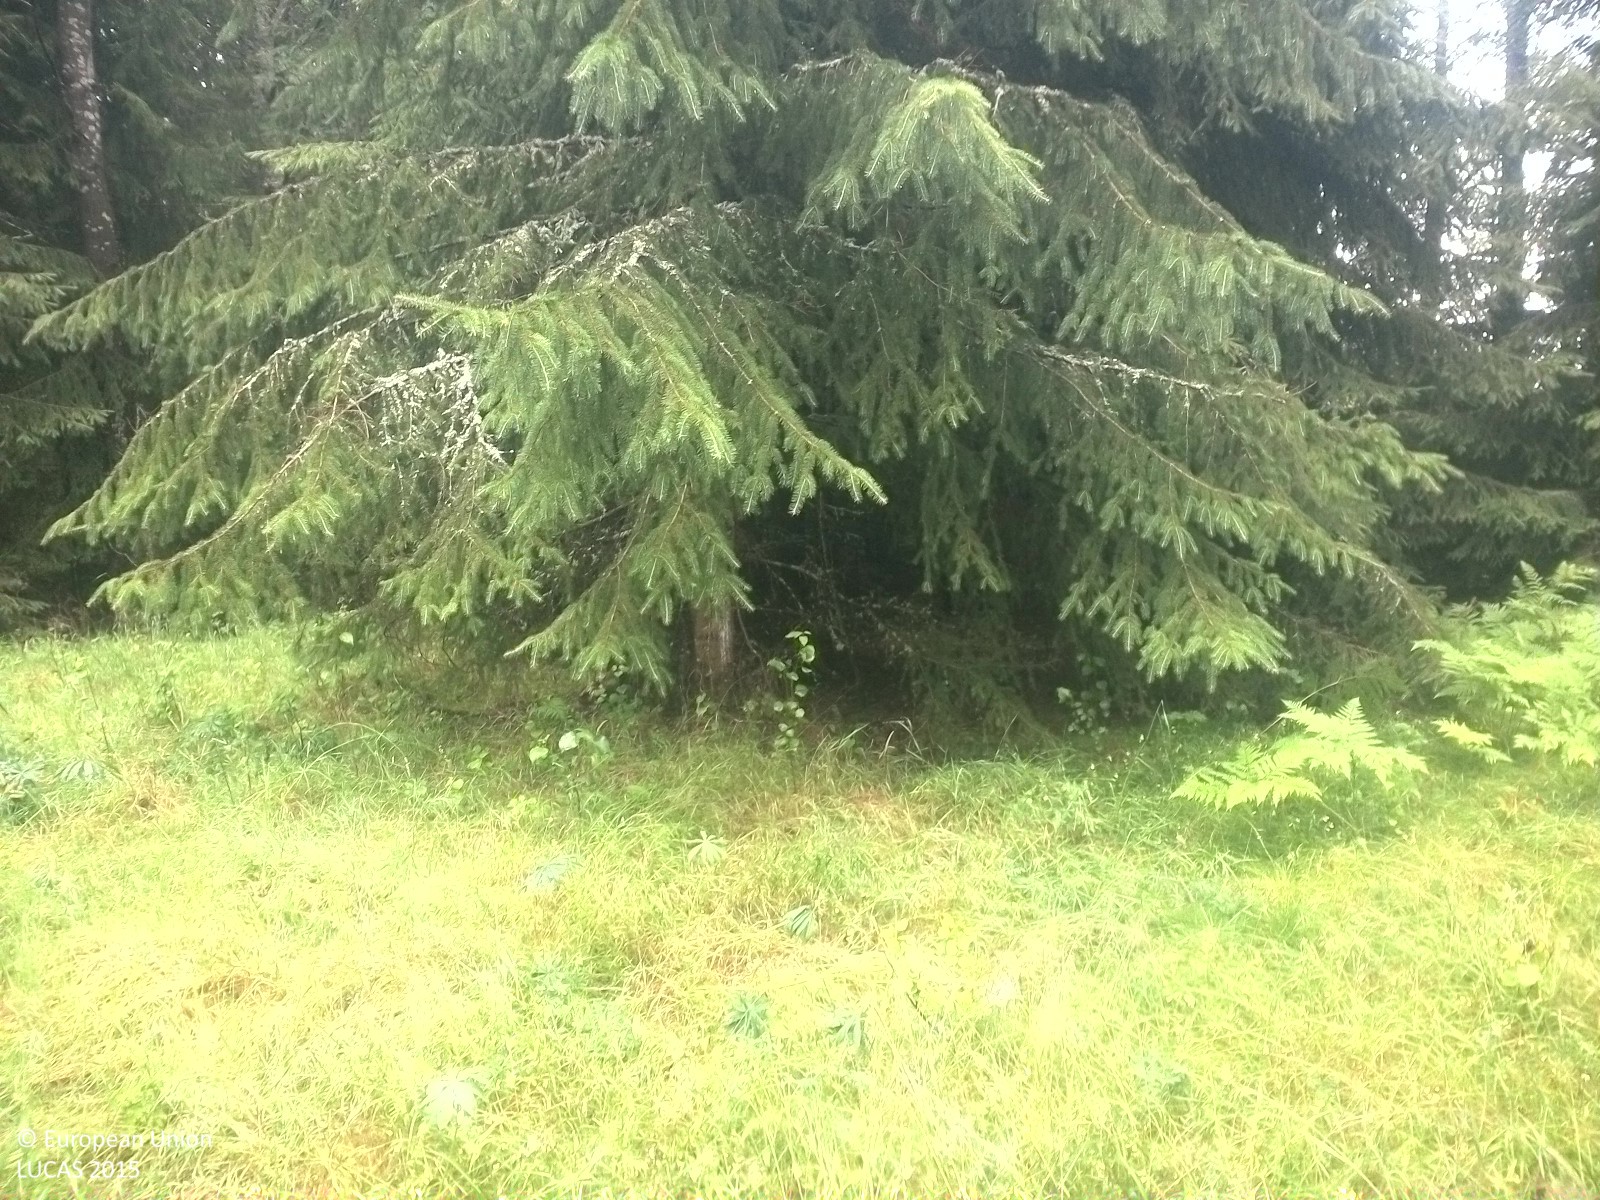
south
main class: Grassland
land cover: Grassland without tree/shrub cover
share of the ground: > 75 %
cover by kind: herbaceous plants 100 %
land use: Semi-natural and natural areas not in use
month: July
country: SE
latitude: 58.9360
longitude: 15.0487
